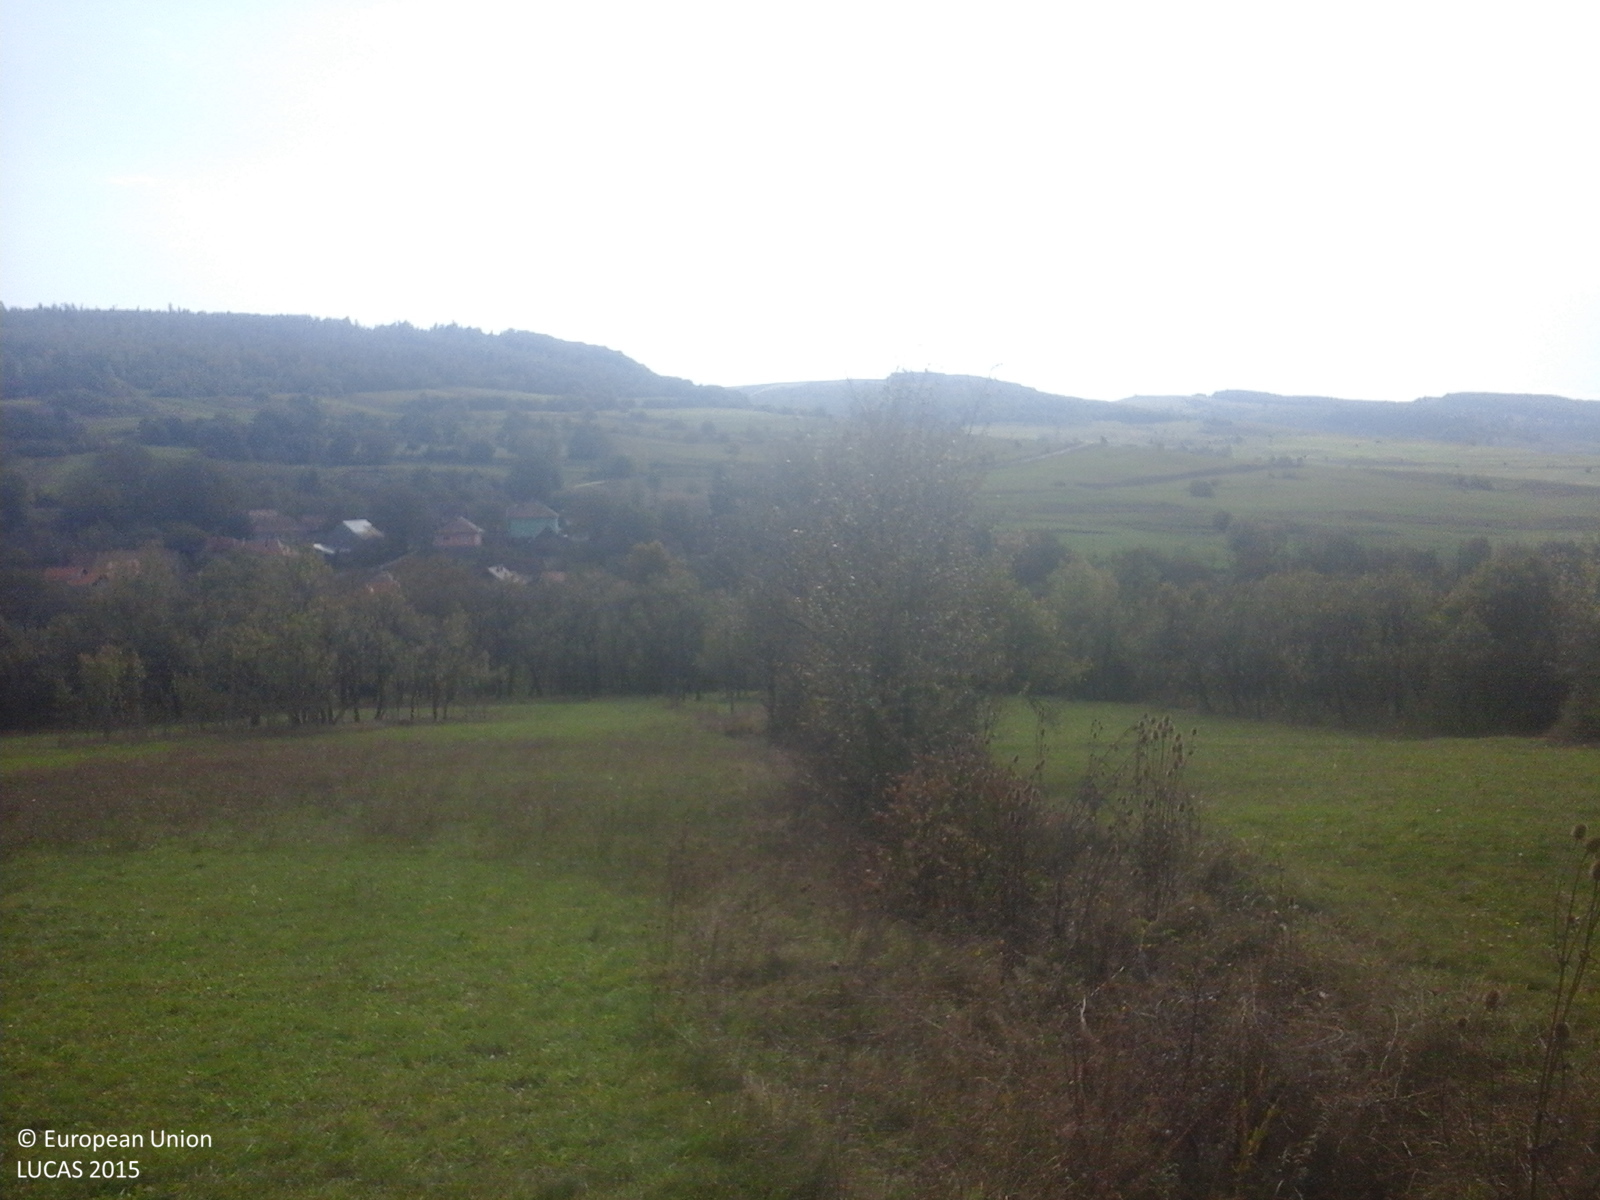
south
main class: Grassland
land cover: Grassland without tree/shrub cover
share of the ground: > 75 %
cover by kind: herbaceous plants 100 %
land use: Agriculture (excluding fallow land and kitchen gardens)
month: October
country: RO
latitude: 46.2474
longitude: 25.3169
